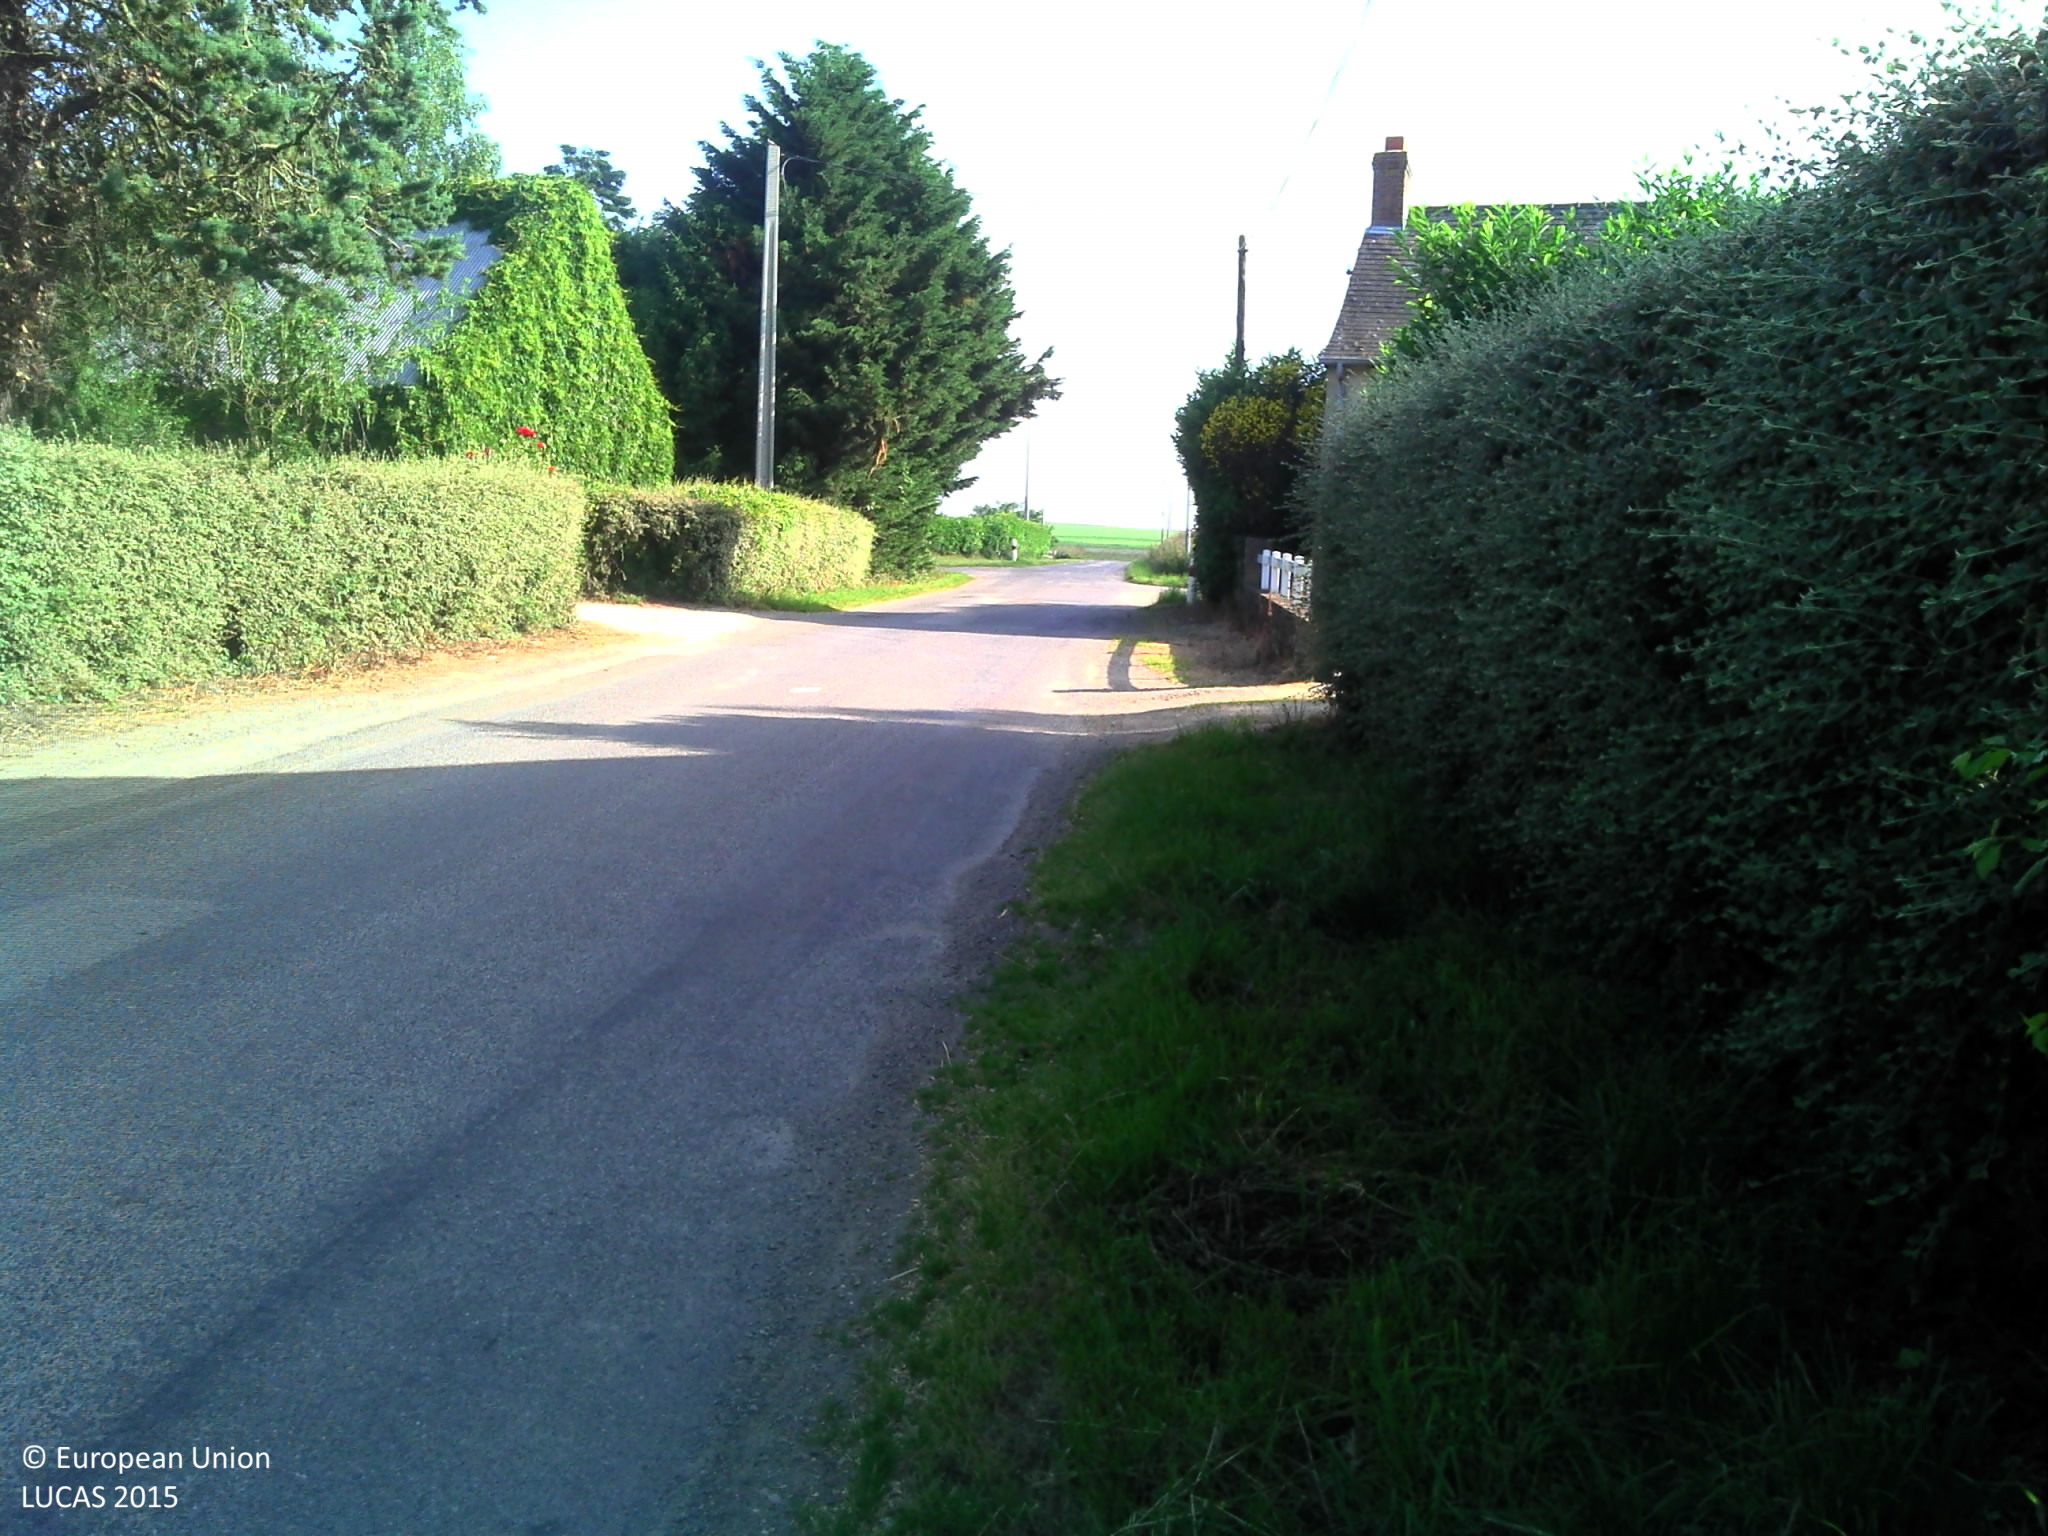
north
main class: Grassland
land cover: Grassland with sparse tree/shrub cover
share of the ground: > 75 %
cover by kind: herbaceous plants 95 %, broadleaved forest trees 5 %
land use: Residential
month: June
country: FR
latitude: 48.0268
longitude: -1.4290
